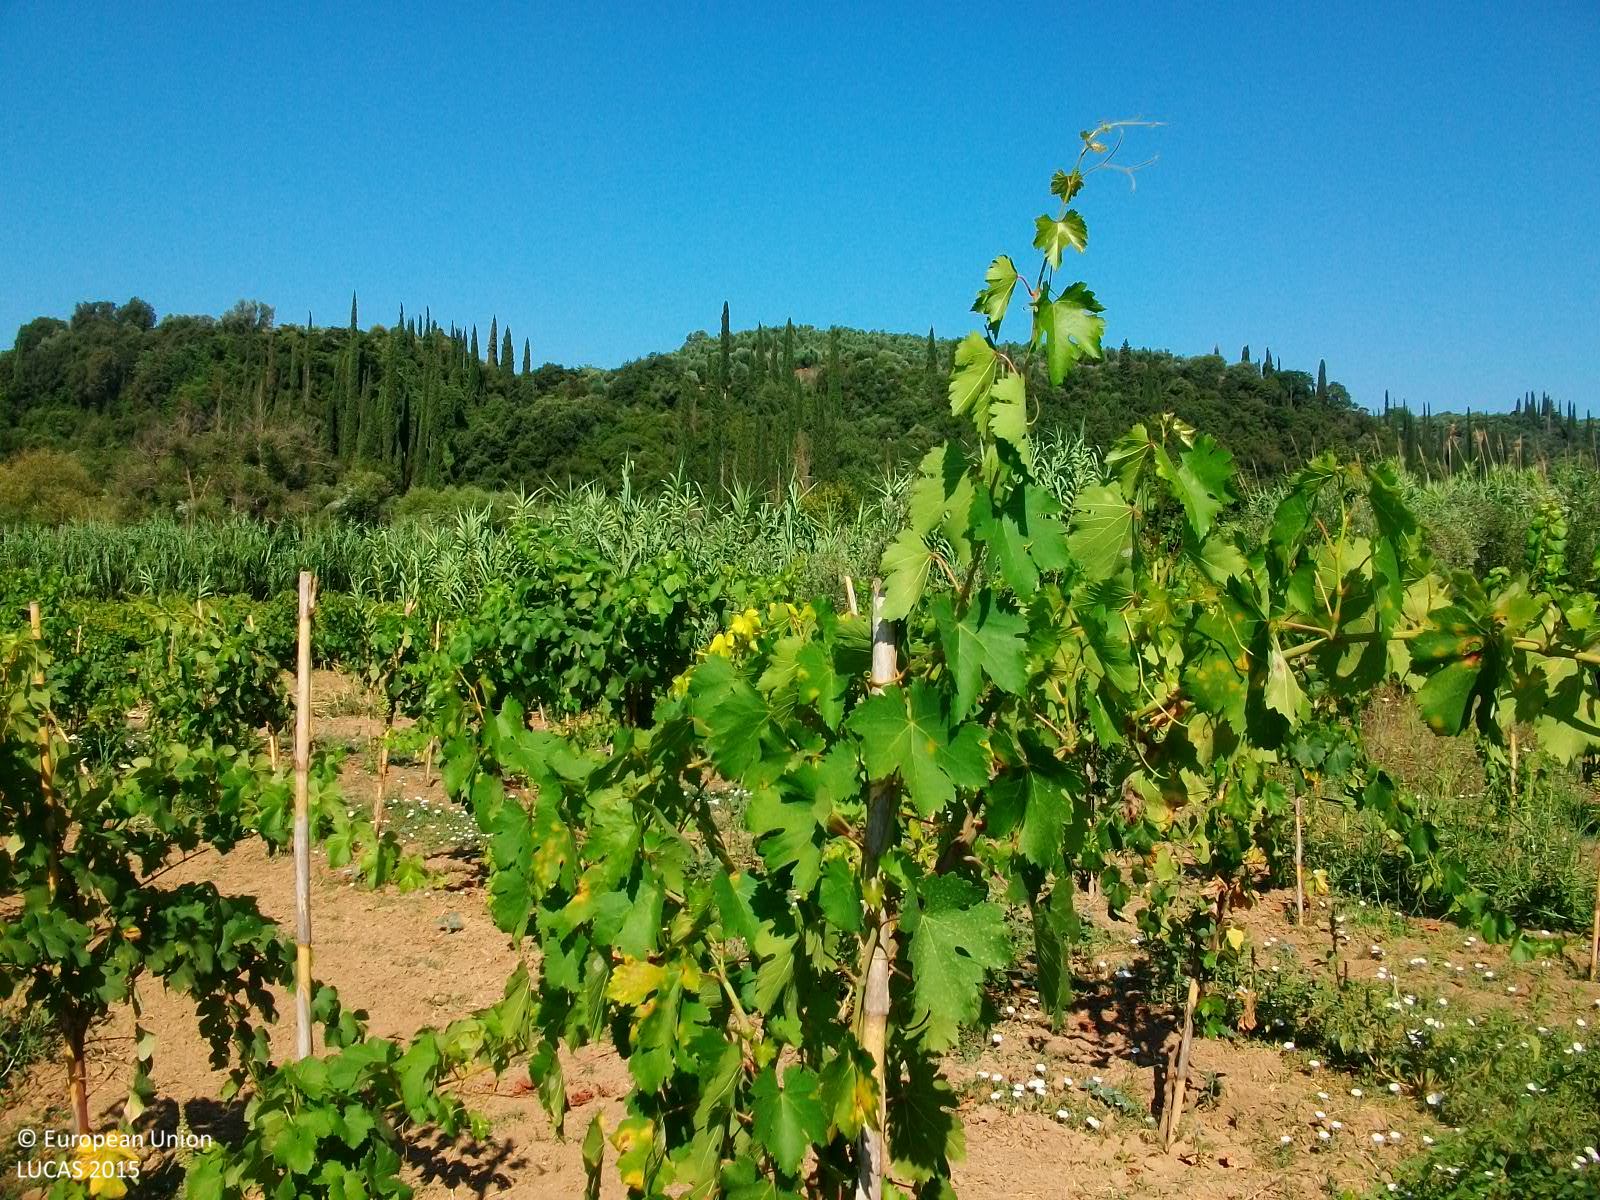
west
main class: Cropland
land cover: Vineyards
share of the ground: 25 - 50 %
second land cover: Spontaneously vegetated surfaces
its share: 25 - 50 %
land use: Agriculture (excluding fallow land and kitchen gardens)
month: July
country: GR
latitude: 37.0460
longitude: 21.9499
